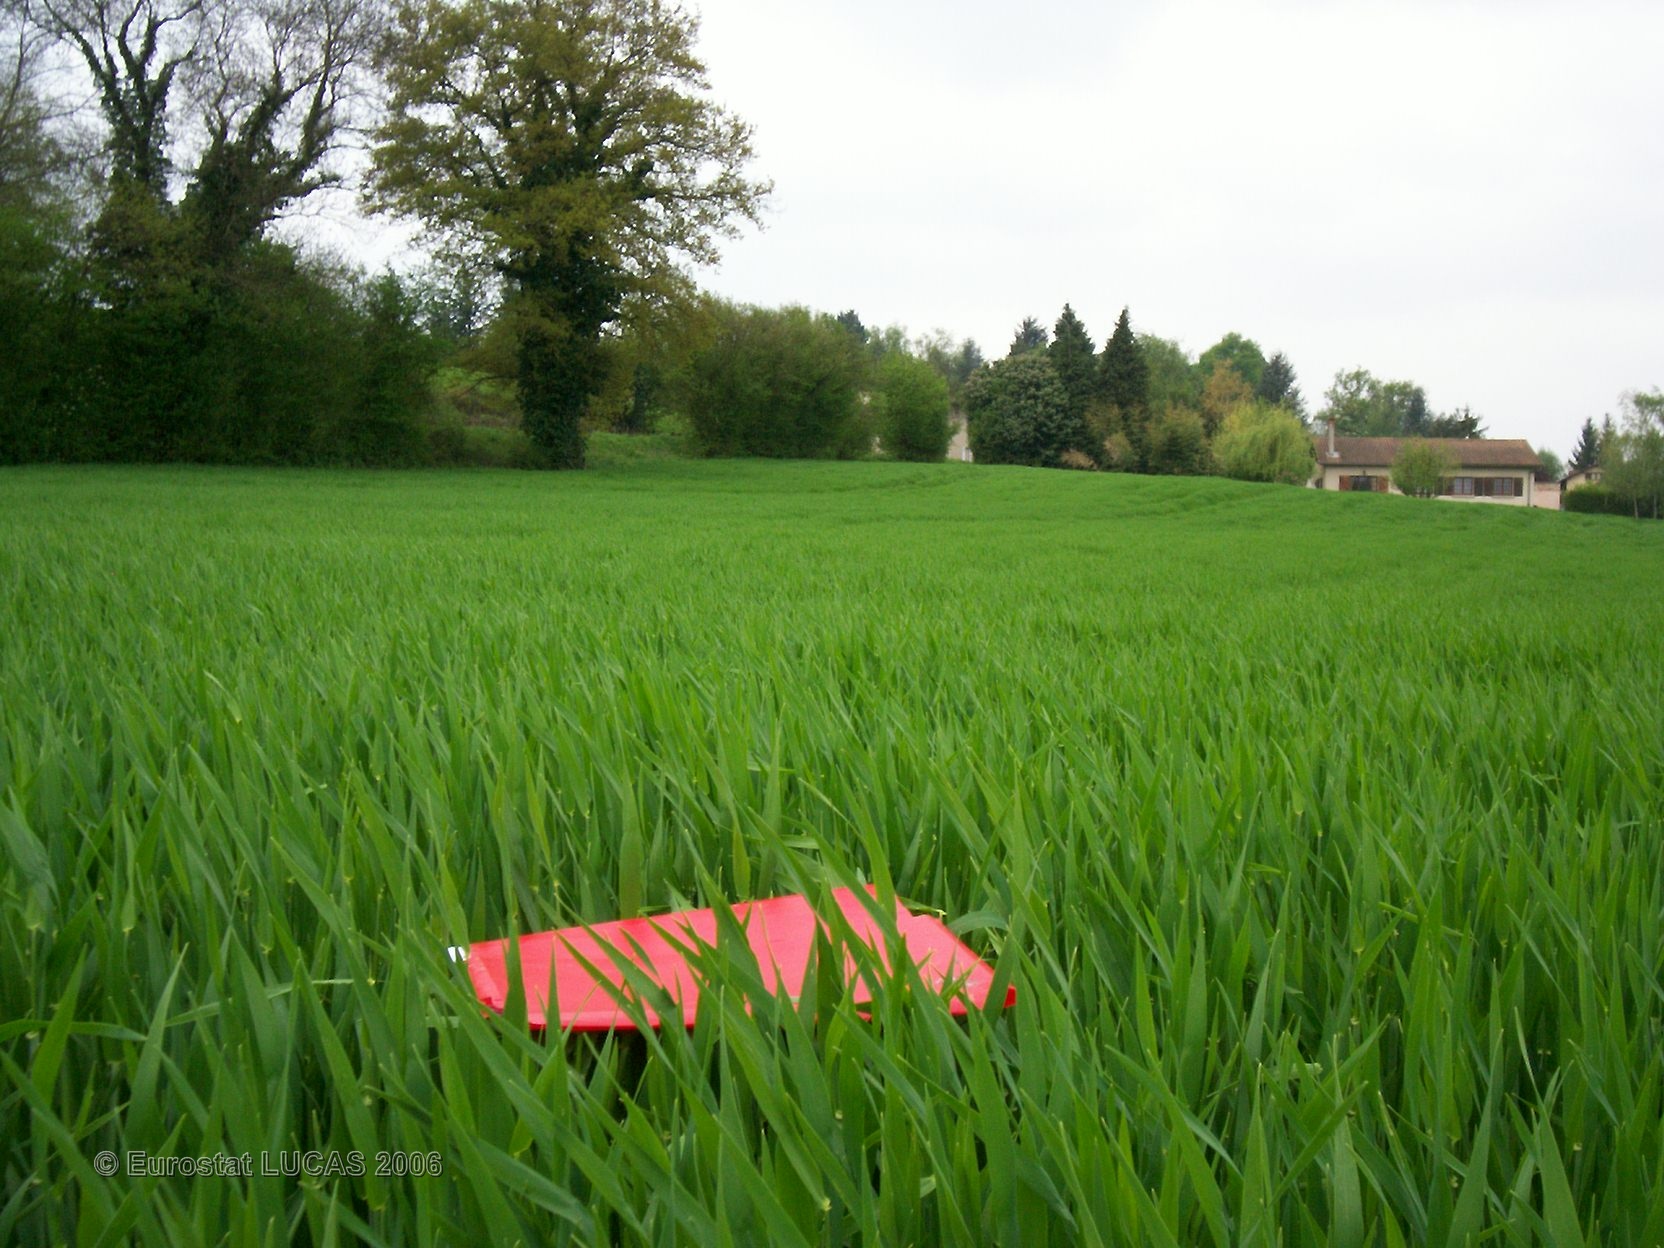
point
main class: Cropland
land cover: Barley
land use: Agriculture (excluding fallow land and kitchen gardens)
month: April
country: FR
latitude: 46.0979
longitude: 4.7898
